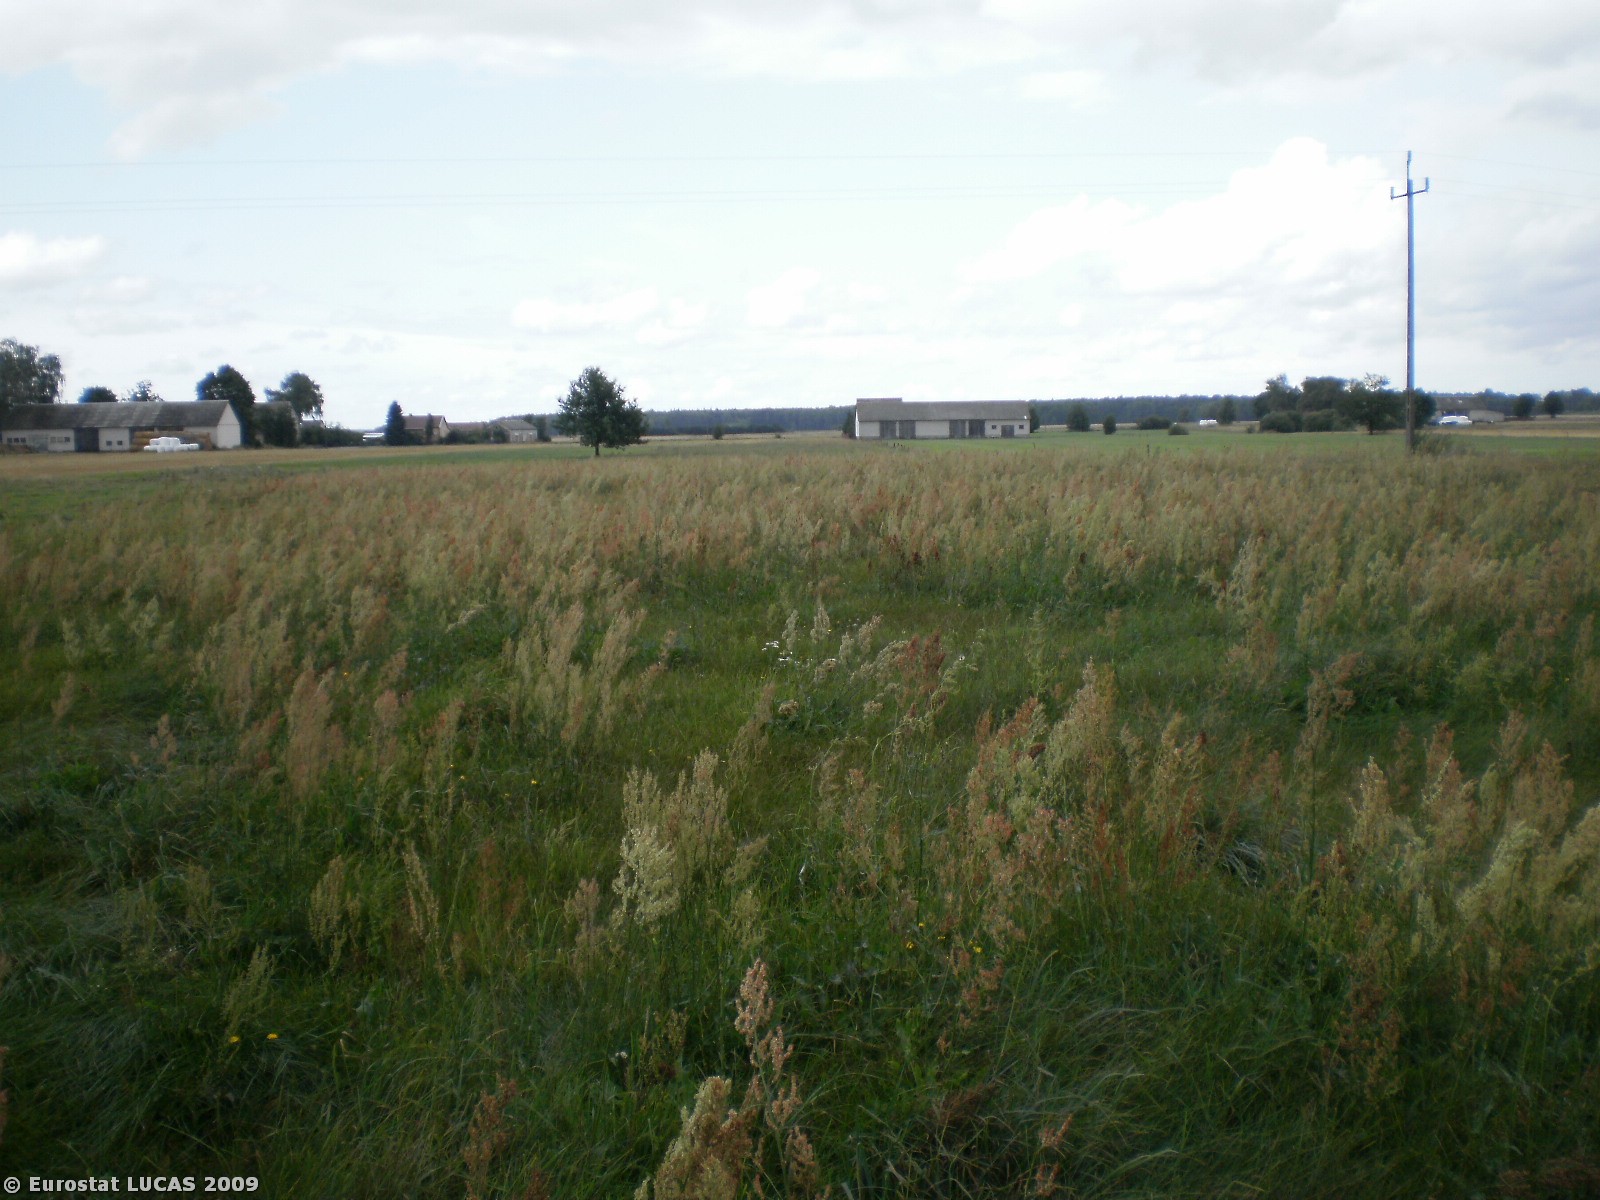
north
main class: Grassland
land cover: Grassland without tree/shrub cover
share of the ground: > 75 %
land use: Agriculture (excluding fallow land and kitchen gardens)
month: August
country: PL
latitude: 52.9205
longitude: 21.7294
